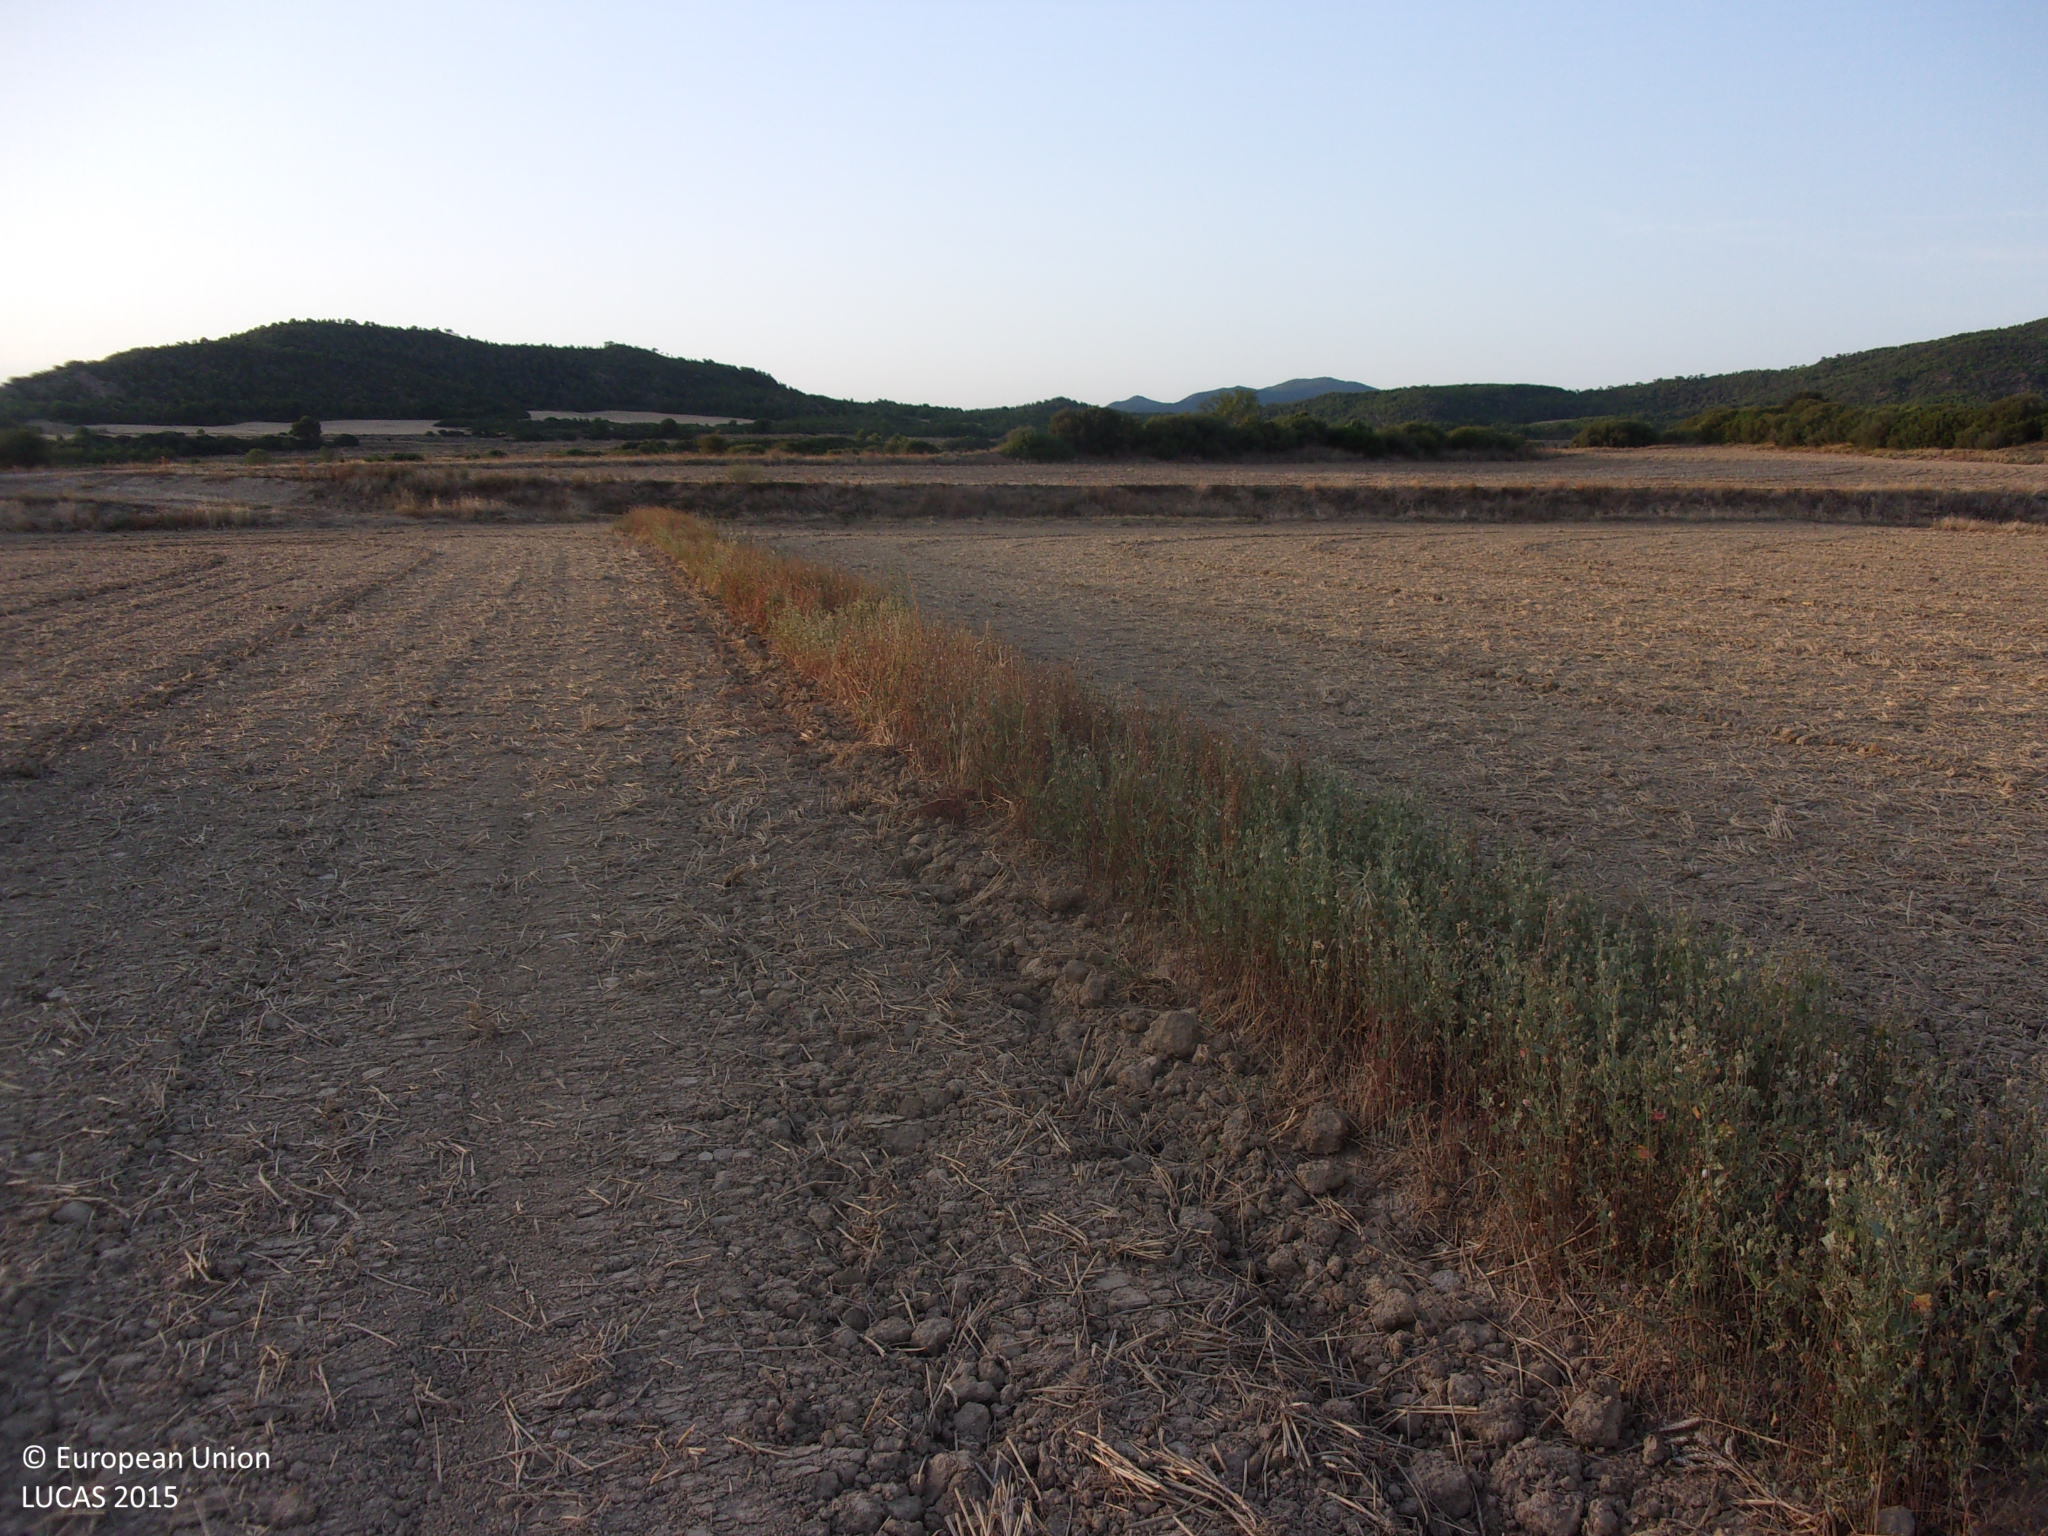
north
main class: Cropland
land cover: Common wheat
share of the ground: < 10 %
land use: Agriculture (excluding fallow land and kitchen gardens)
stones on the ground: < 10 %
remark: Harvested field
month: August
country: ES
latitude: 42.4275
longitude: -1.3977
